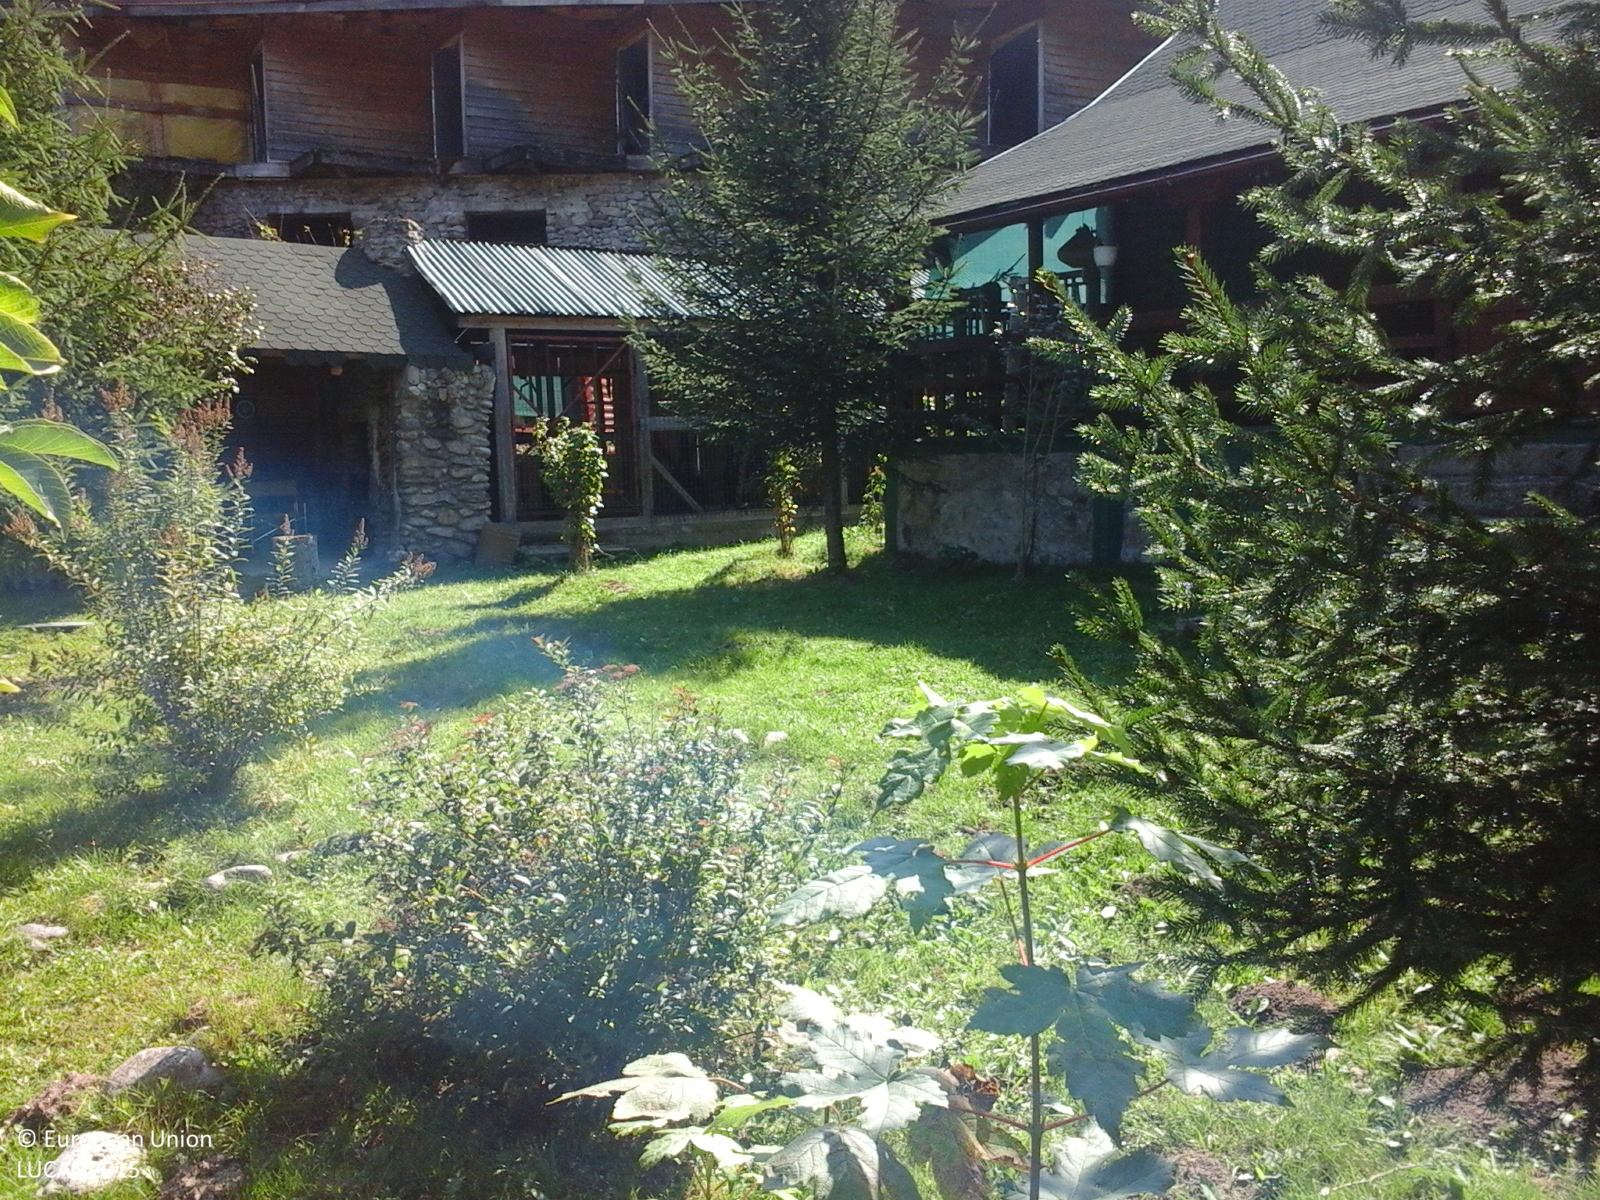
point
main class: Grassland
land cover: Grassland with sparse tree/shrub cover
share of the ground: > 75 %
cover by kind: herbaceous plants 85 %, shrubs 10 %, broadleaved forest trees 5 %
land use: Agriculture (excluding fallow land and kitchen gardens)
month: September
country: RO
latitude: 46.7910
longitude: 22.5648
